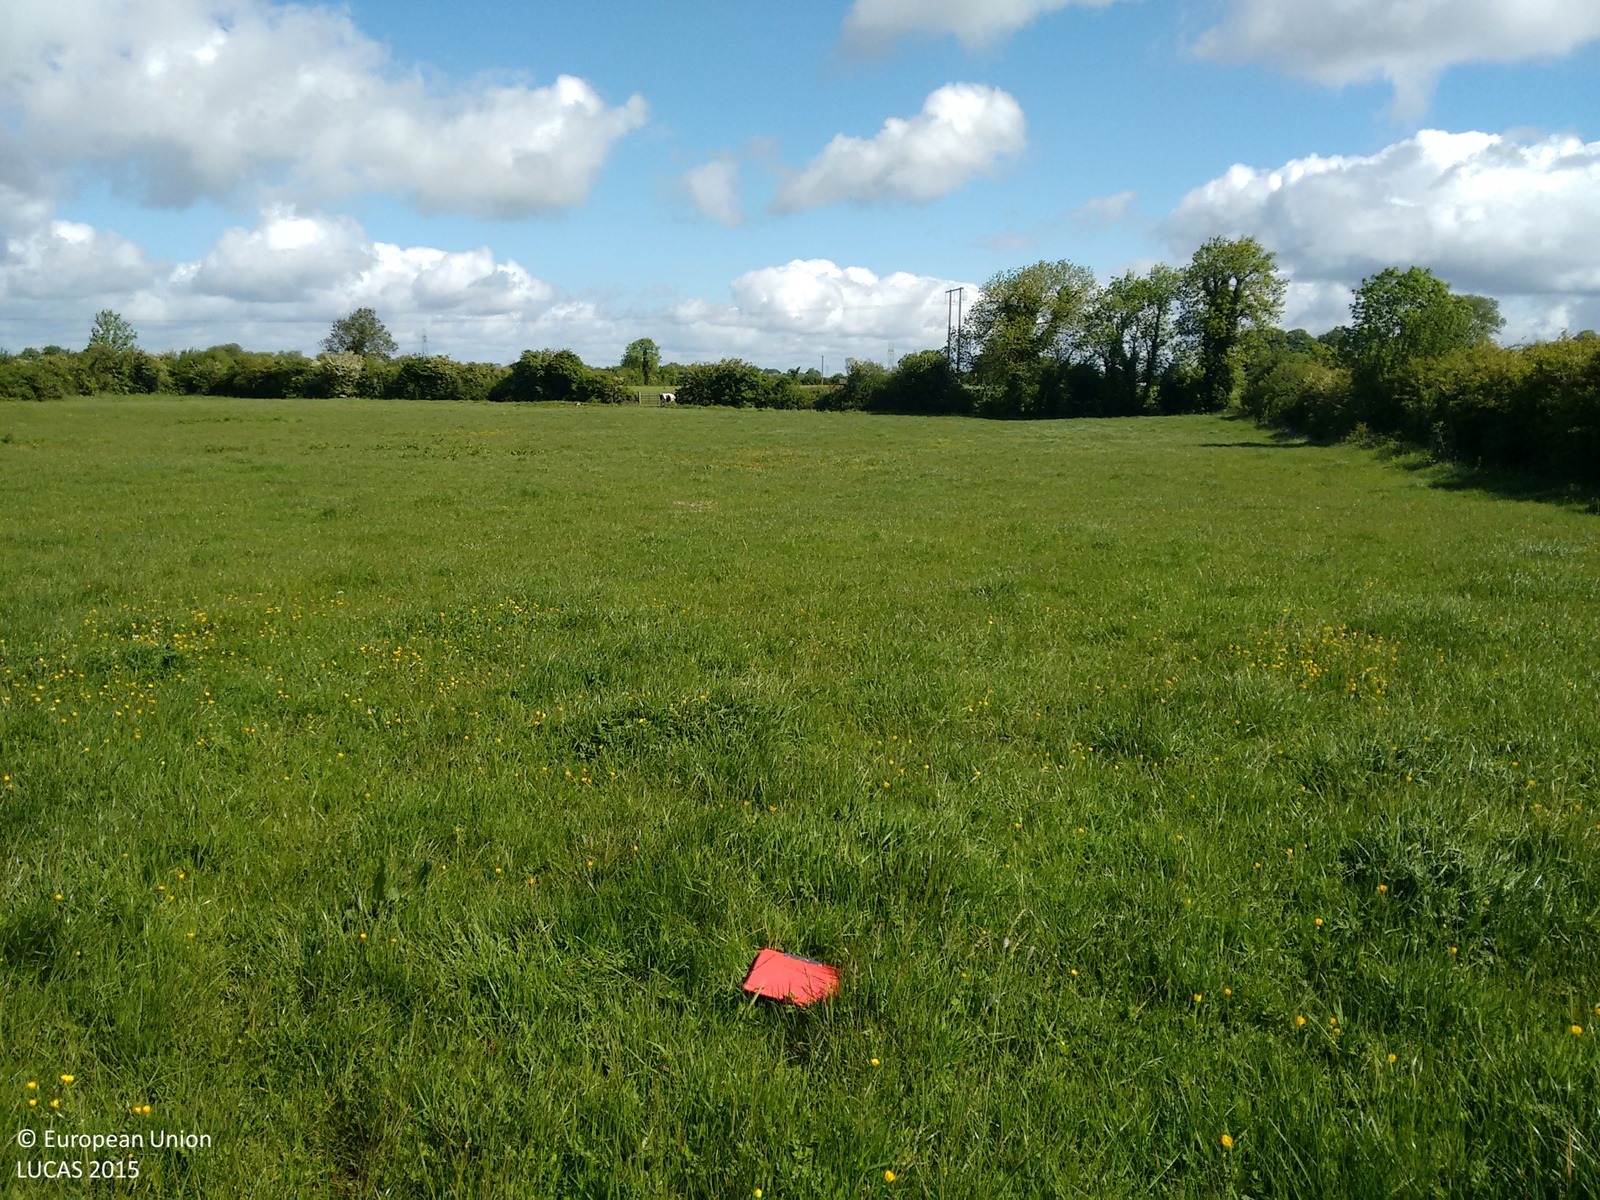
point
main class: Grassland
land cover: Grassland without tree/shrub cover
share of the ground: > 75 %
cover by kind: herbaceous plants 100 %
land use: Agriculture (excluding fallow land and kitchen gardens)
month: June
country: IE
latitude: 53.3878
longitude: -6.9660
